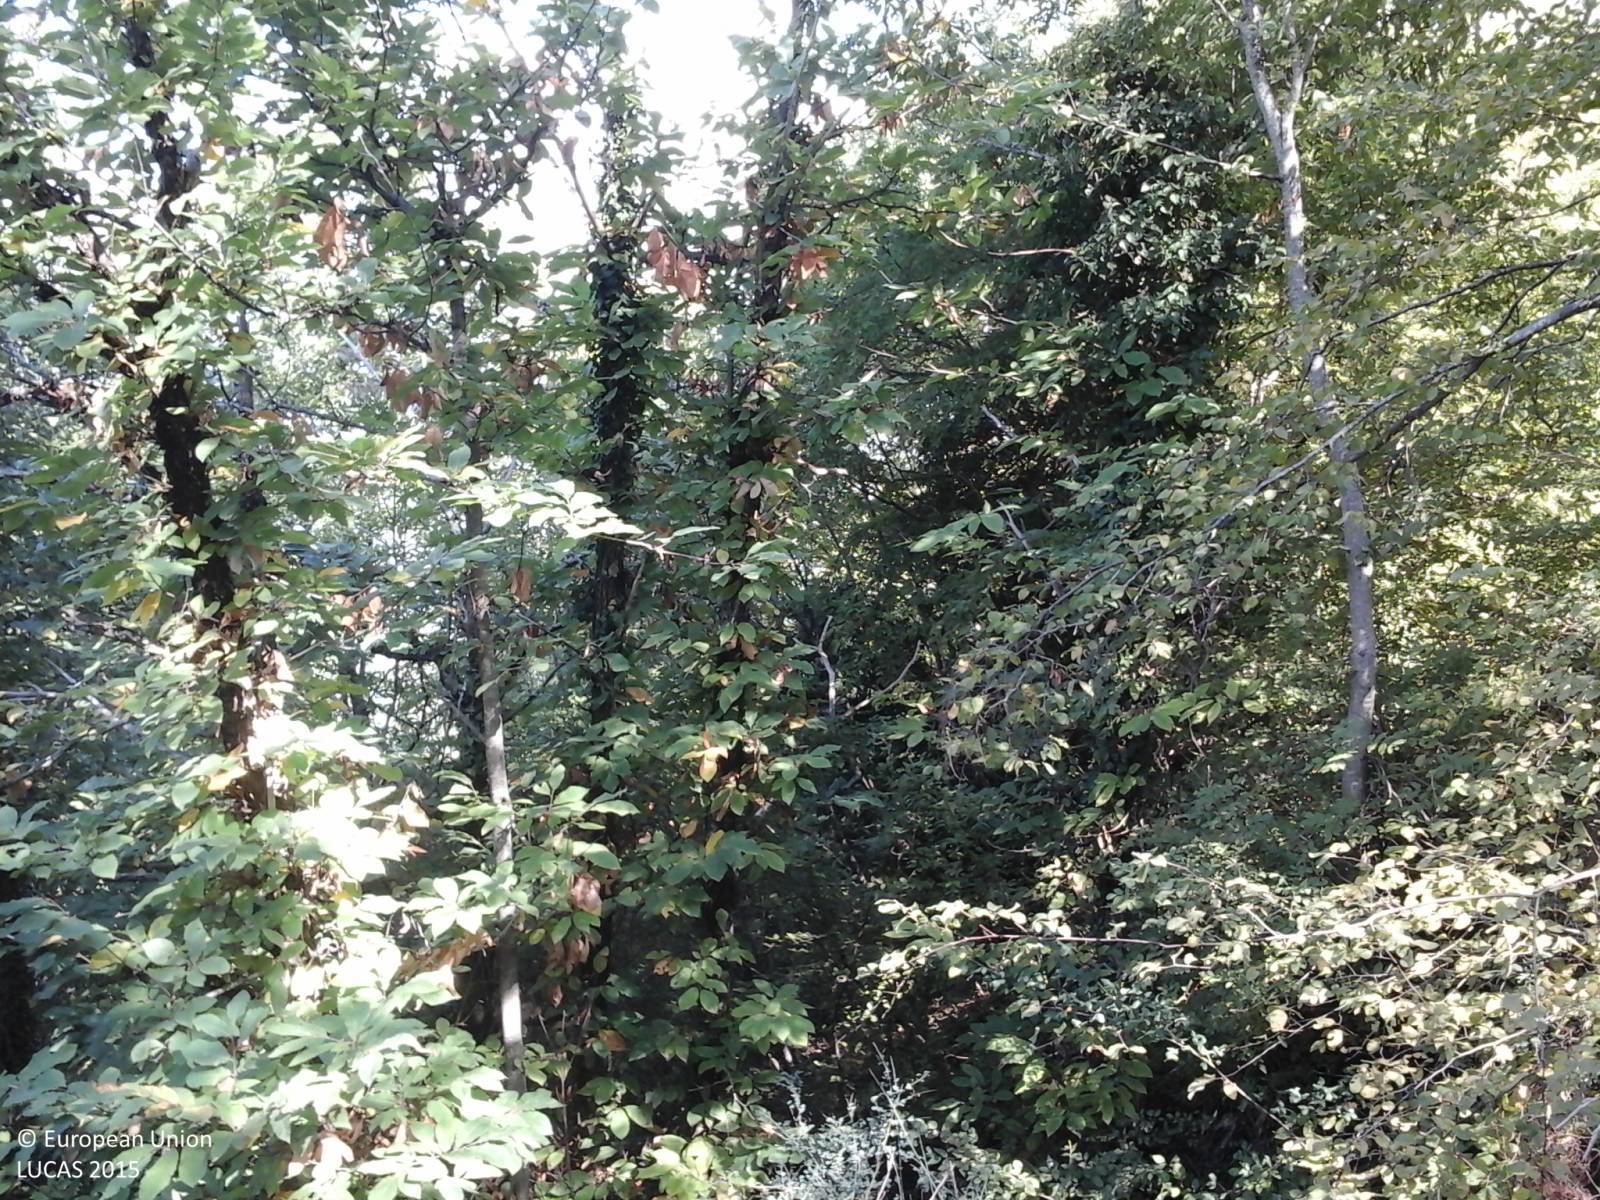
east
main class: Woodland
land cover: Broadleaved woodland
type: thermophilous deciduous forest
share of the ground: > 75 %
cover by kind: broadleaved forest trees 100 %
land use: Forestry
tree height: > 5 m
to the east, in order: Broadleaved woodland; Tracks; Broadleaved woodland
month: October
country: IT
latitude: 42.3236
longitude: 12.8904
